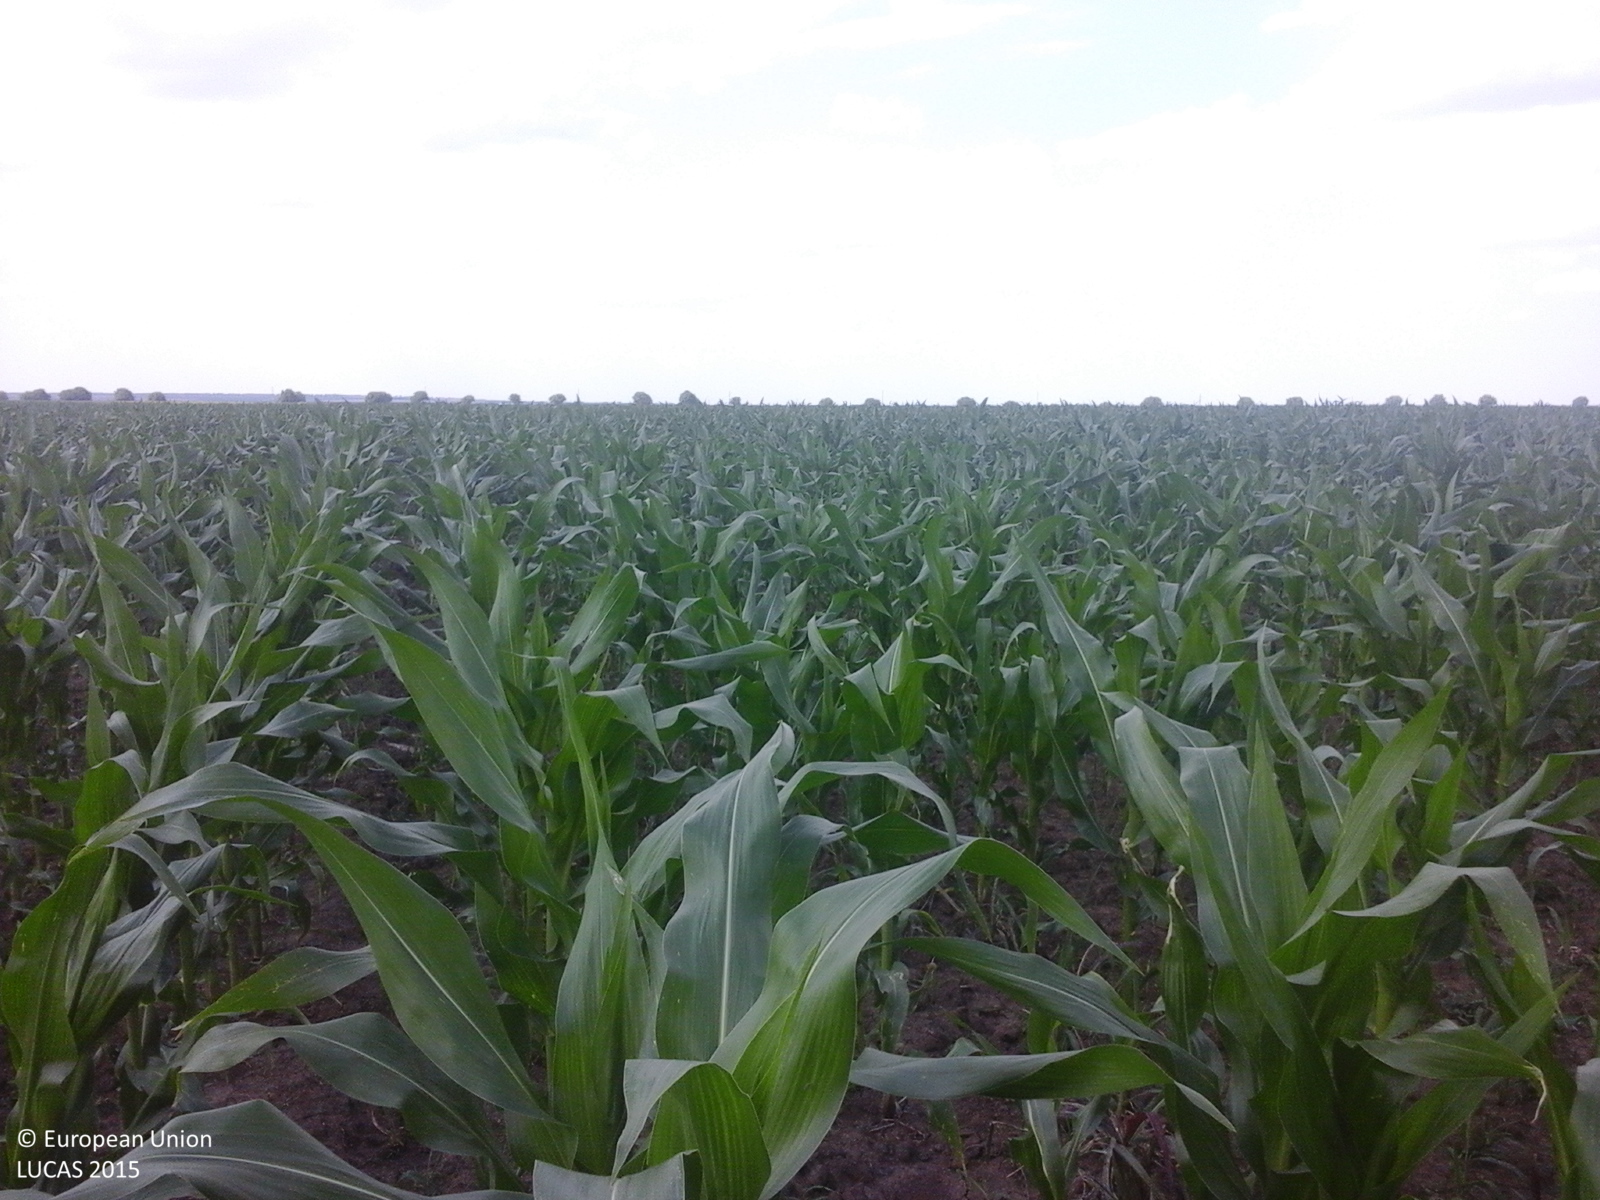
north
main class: Cropland
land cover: Maize
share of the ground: > 75 %
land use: Agriculture (excluding fallow land and kitchen gardens)
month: June
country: RO
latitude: 44.1183
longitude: 26.5190
